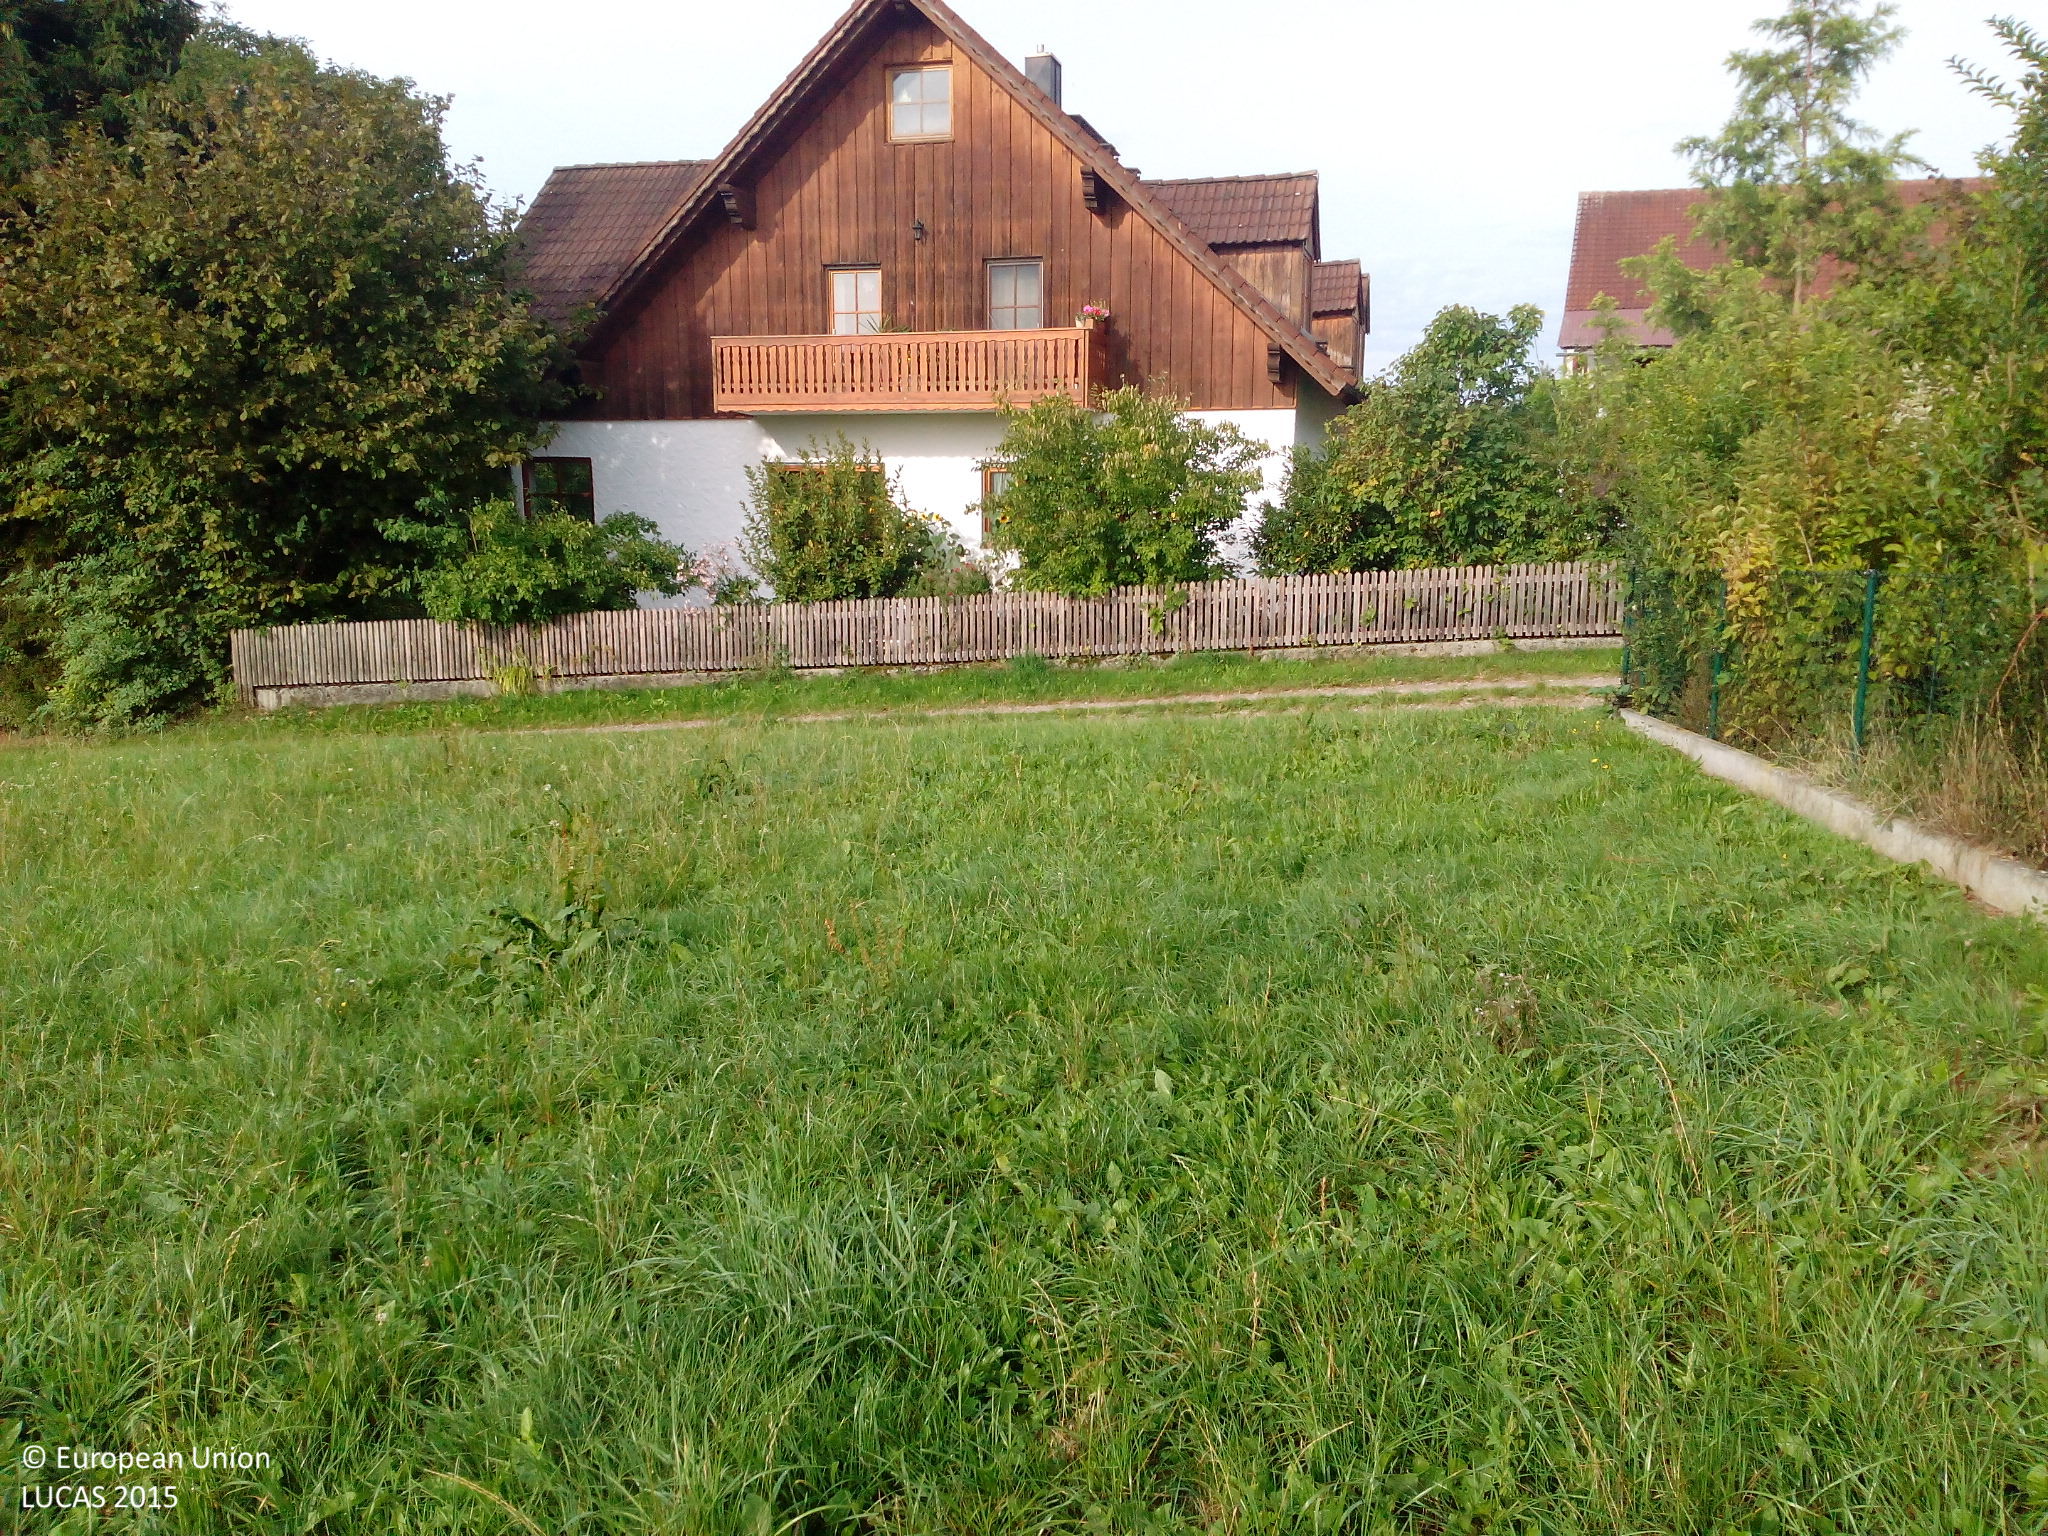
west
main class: Grassland
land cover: Grassland without tree/shrub cover
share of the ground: > 75 %
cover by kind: herbaceous plants 100 %
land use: Residential
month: September
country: DE
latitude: 48.4646
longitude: 11.5545
